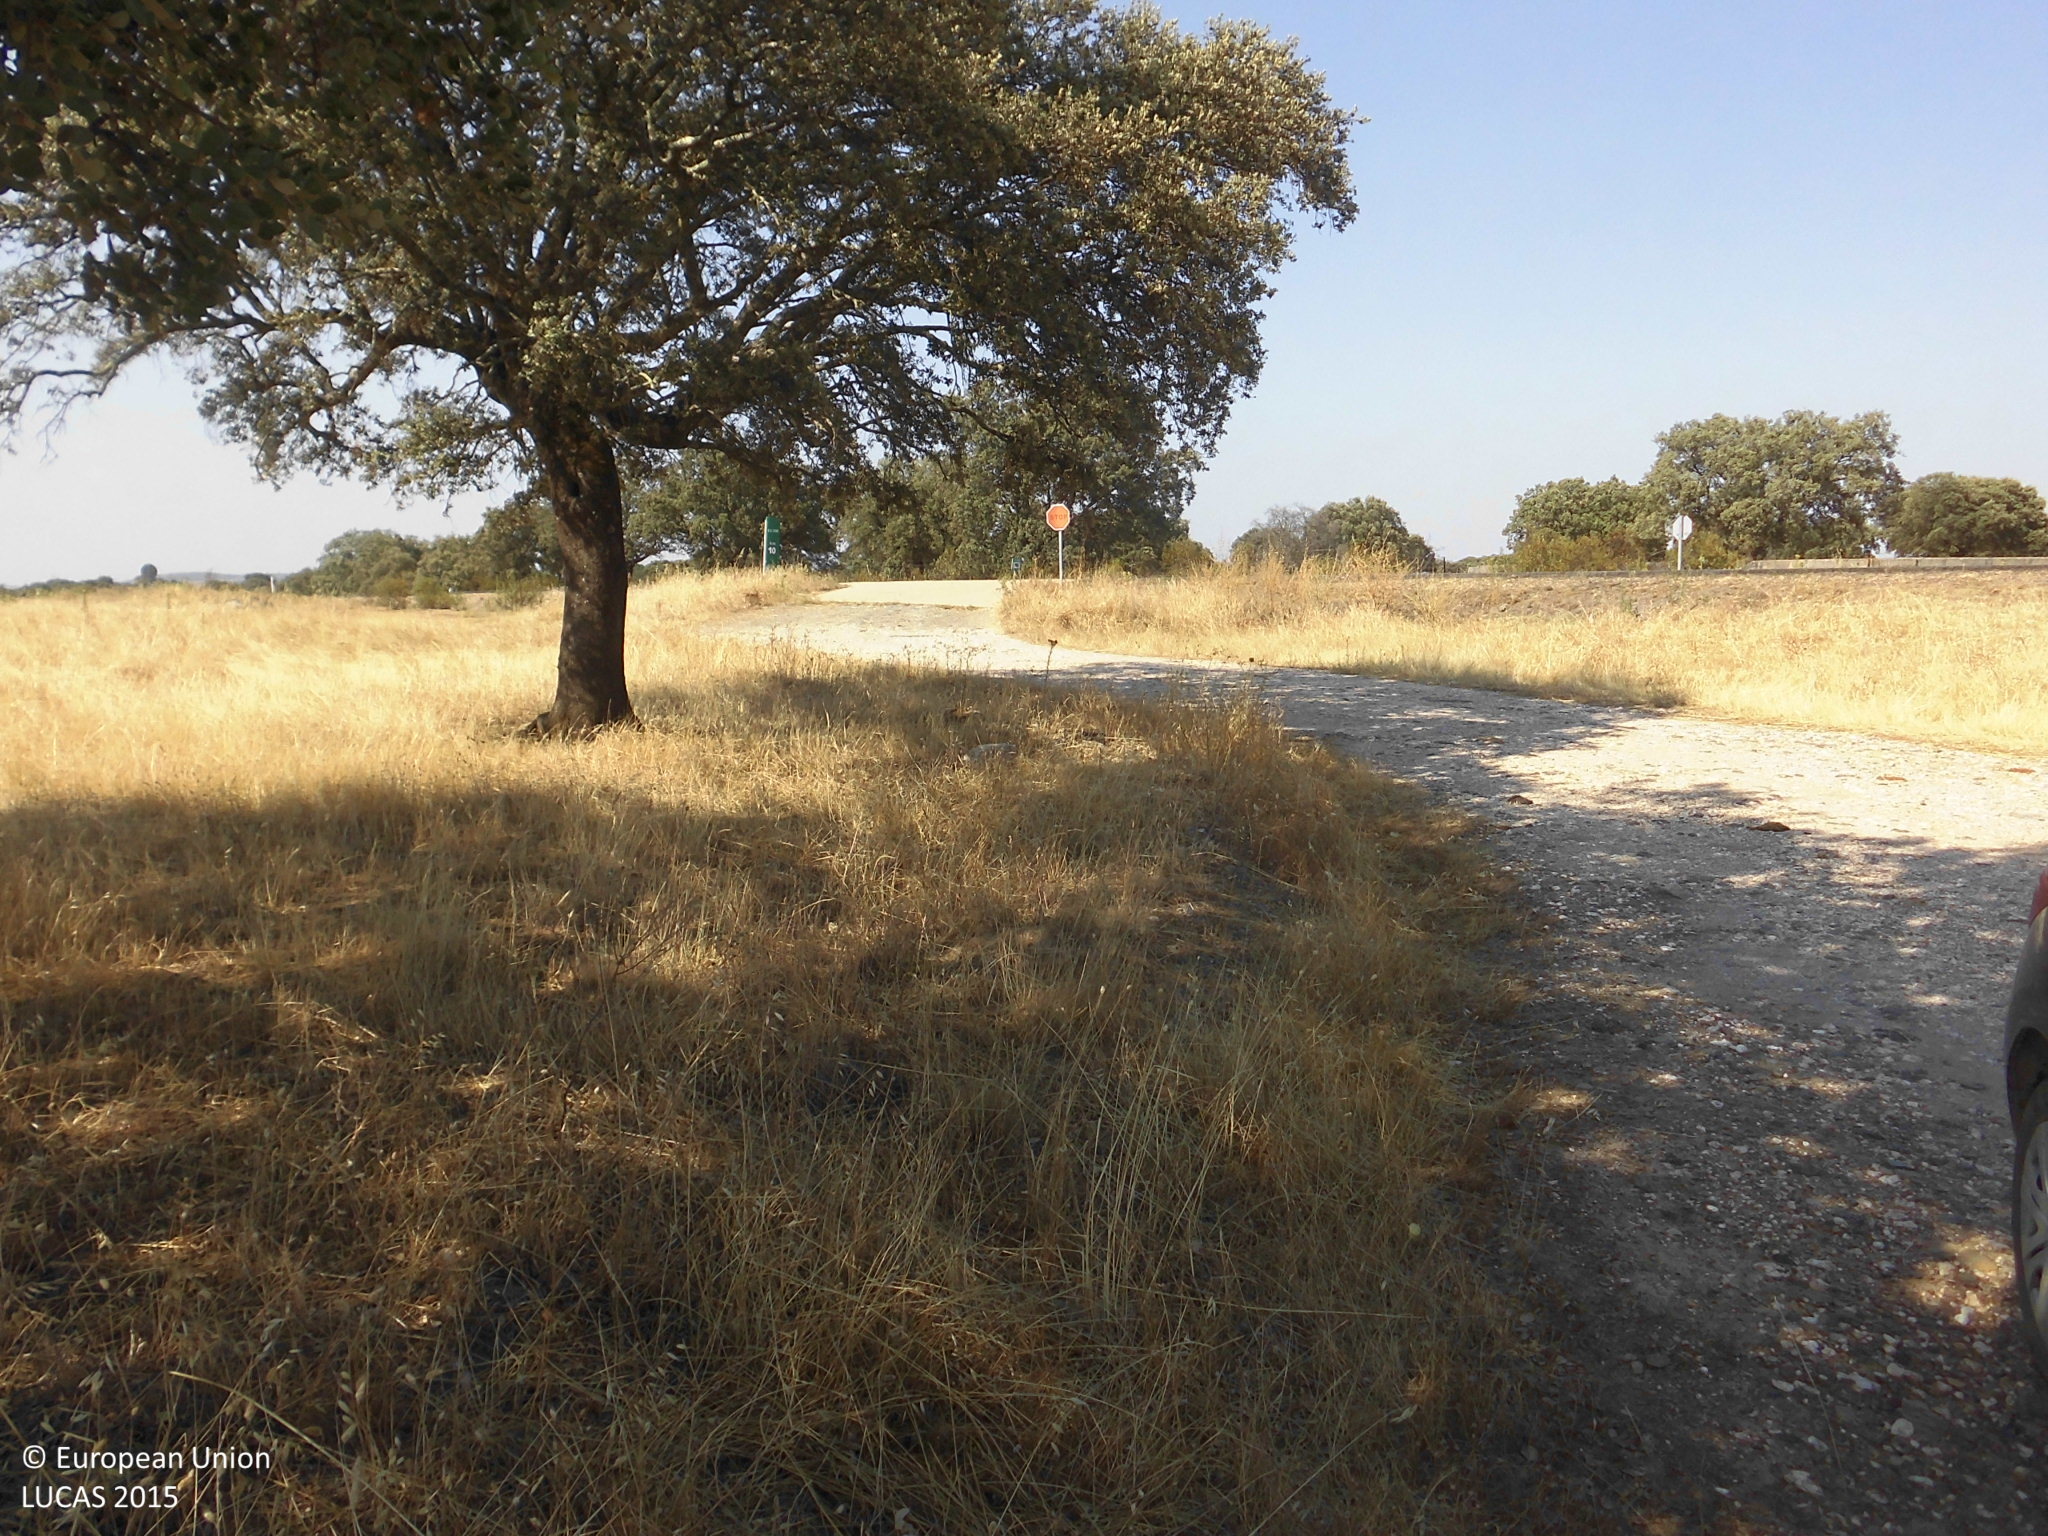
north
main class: Grassland
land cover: Grassland without tree/shrub cover
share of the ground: > 75 %
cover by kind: herbaceous plants 100 %
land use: Agriculture (excluding fallow land and kitchen gardens)
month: June
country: ES
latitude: 39.9238
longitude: -6.0874
